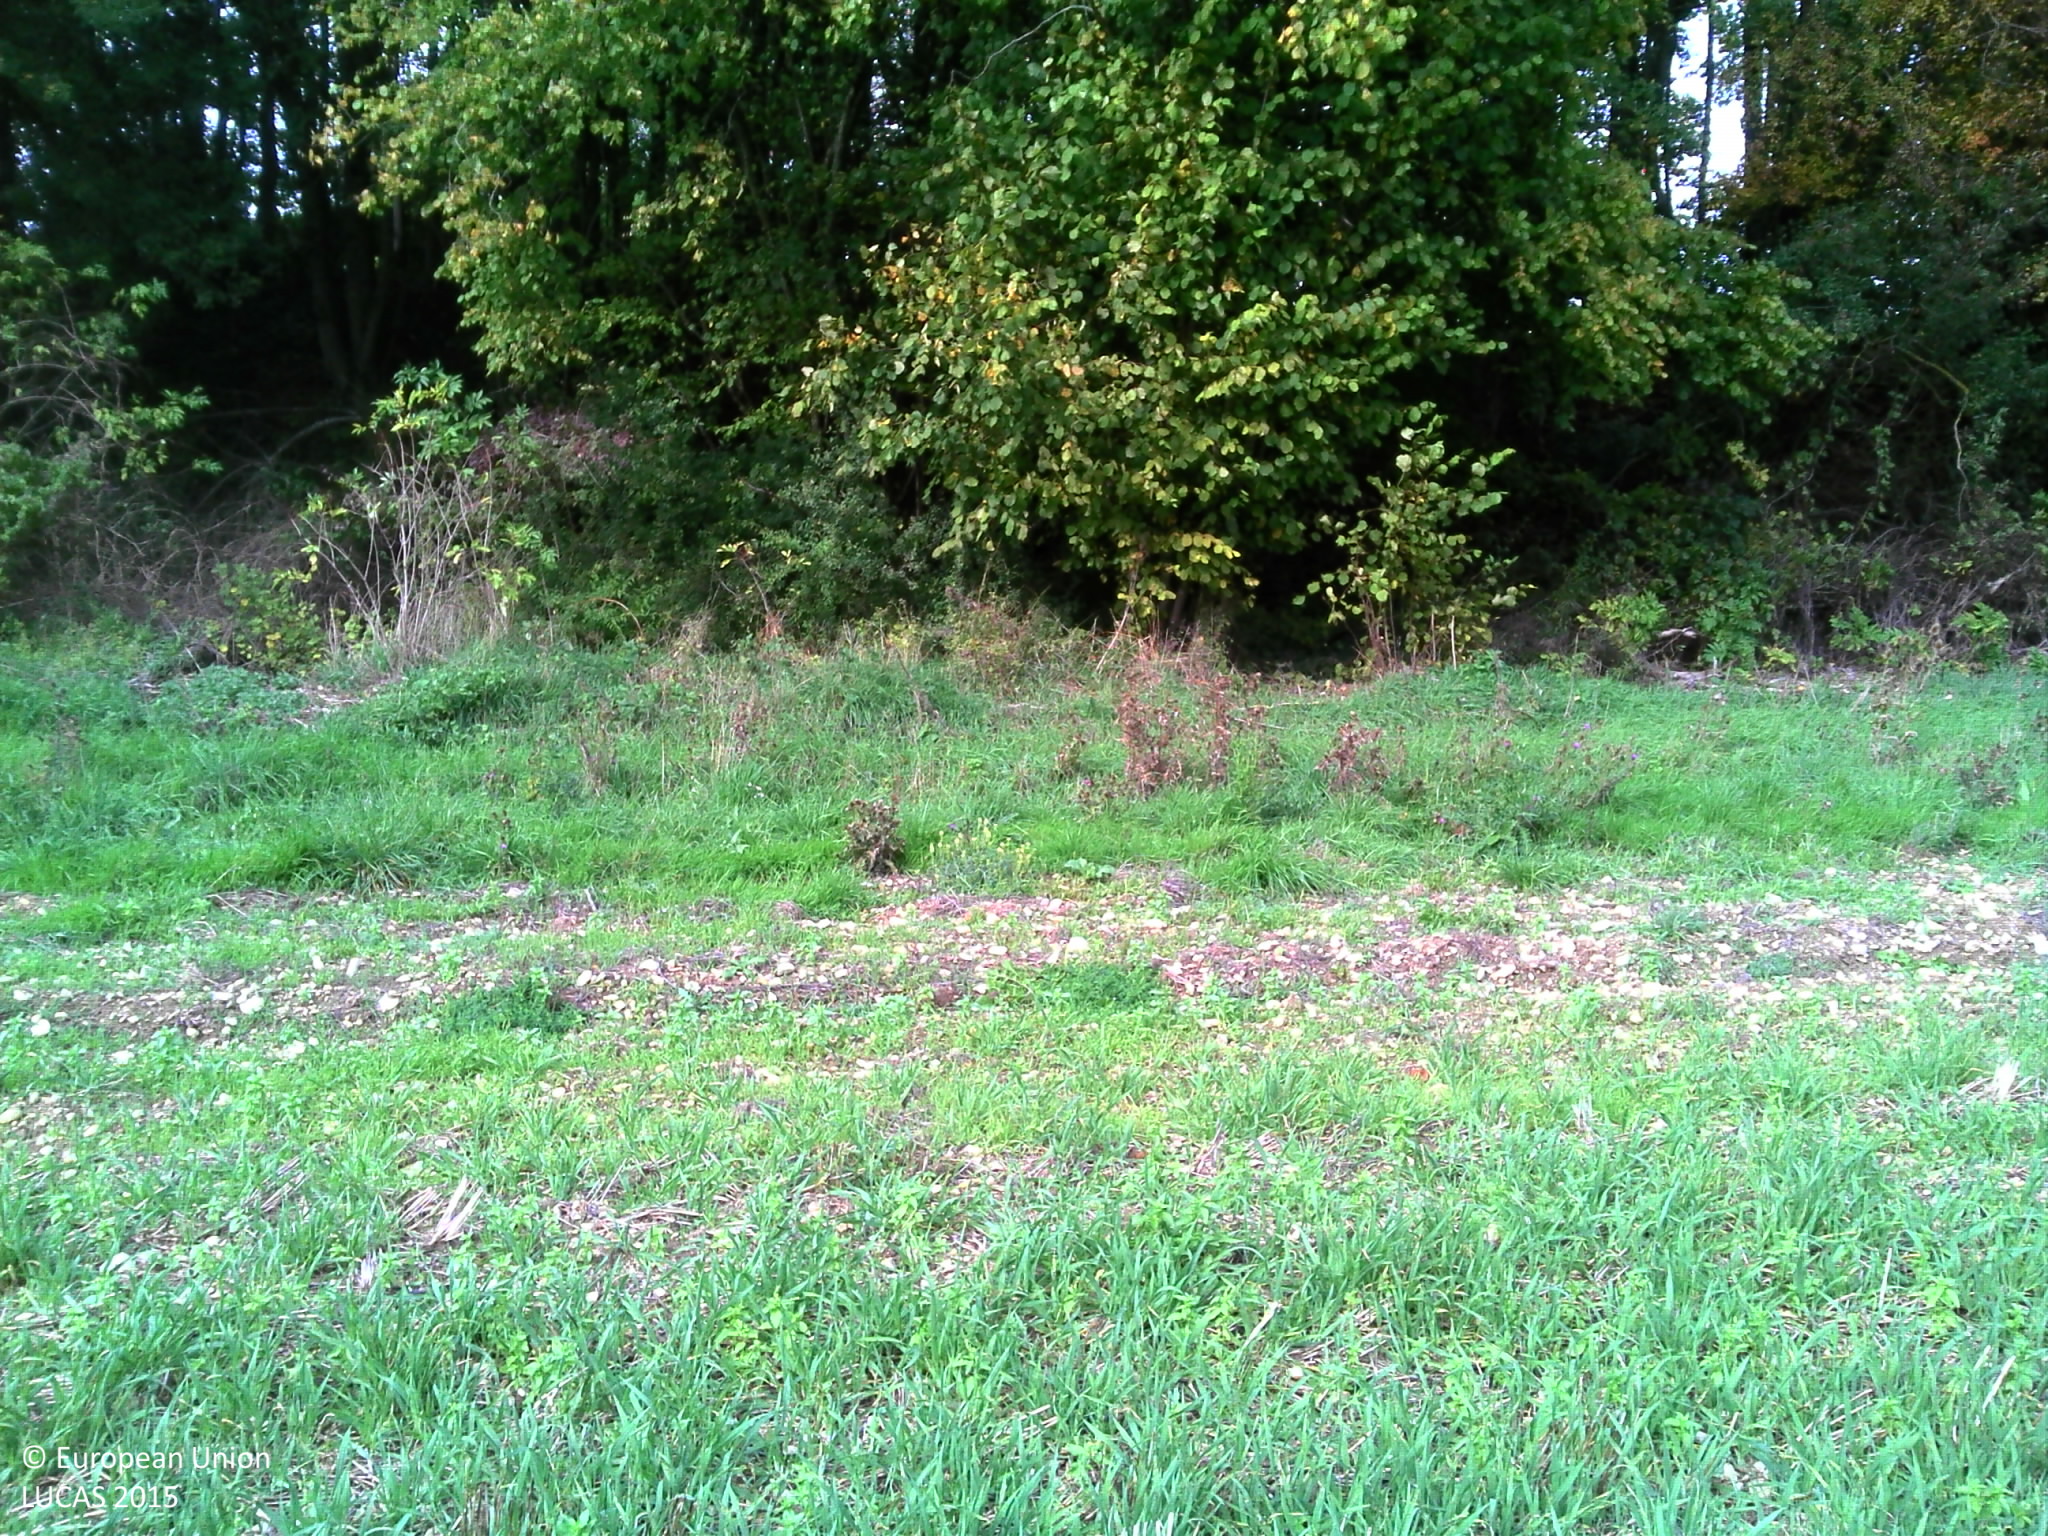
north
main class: Cropland
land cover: Temporary grasslands
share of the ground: > 75 %
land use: Agriculture (excluding fallow land and kitchen gardens)
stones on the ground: < 10 %
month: October
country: FR
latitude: 48.2009
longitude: 4.6296
